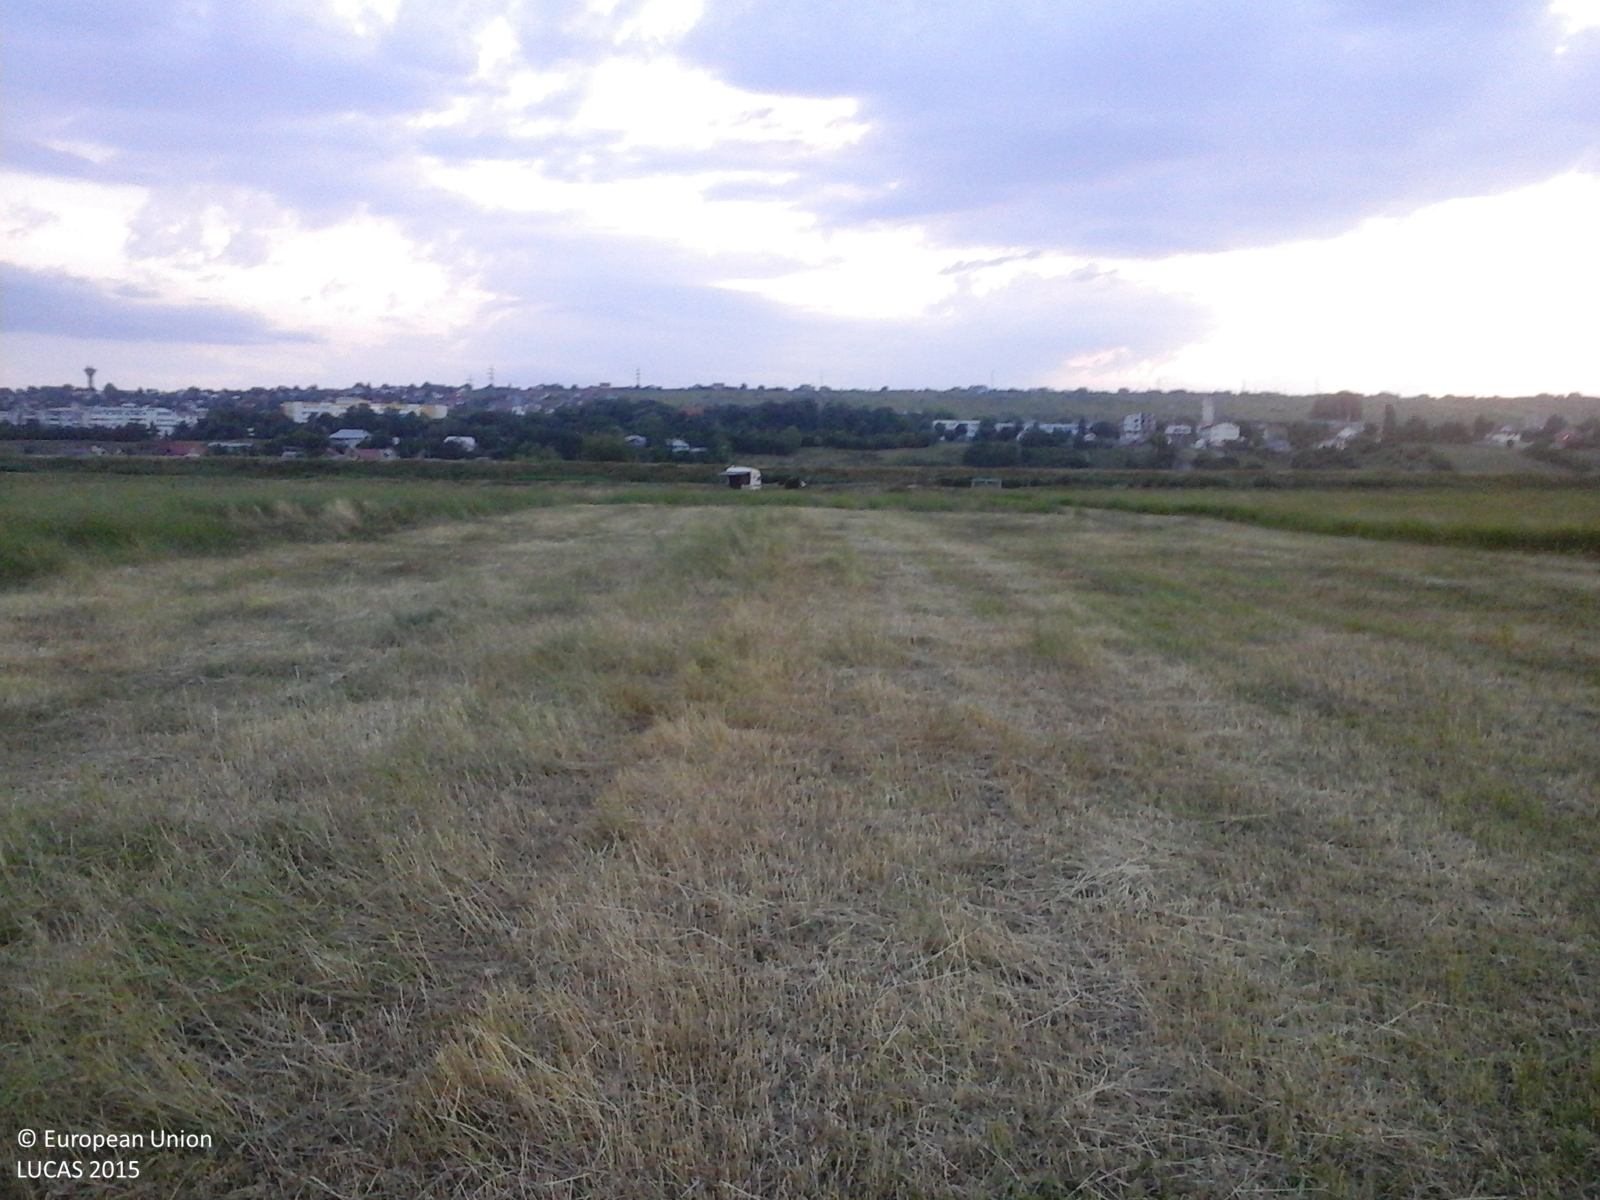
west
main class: Grassland
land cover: Grassland without tree/shrub cover
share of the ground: 10 - 25 %
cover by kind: herbaceous plants 100 %
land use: Agriculture (excluding fallow land and kitchen gardens)
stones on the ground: < 10 %
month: June
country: RO
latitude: 46.6571
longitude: 27.7483
